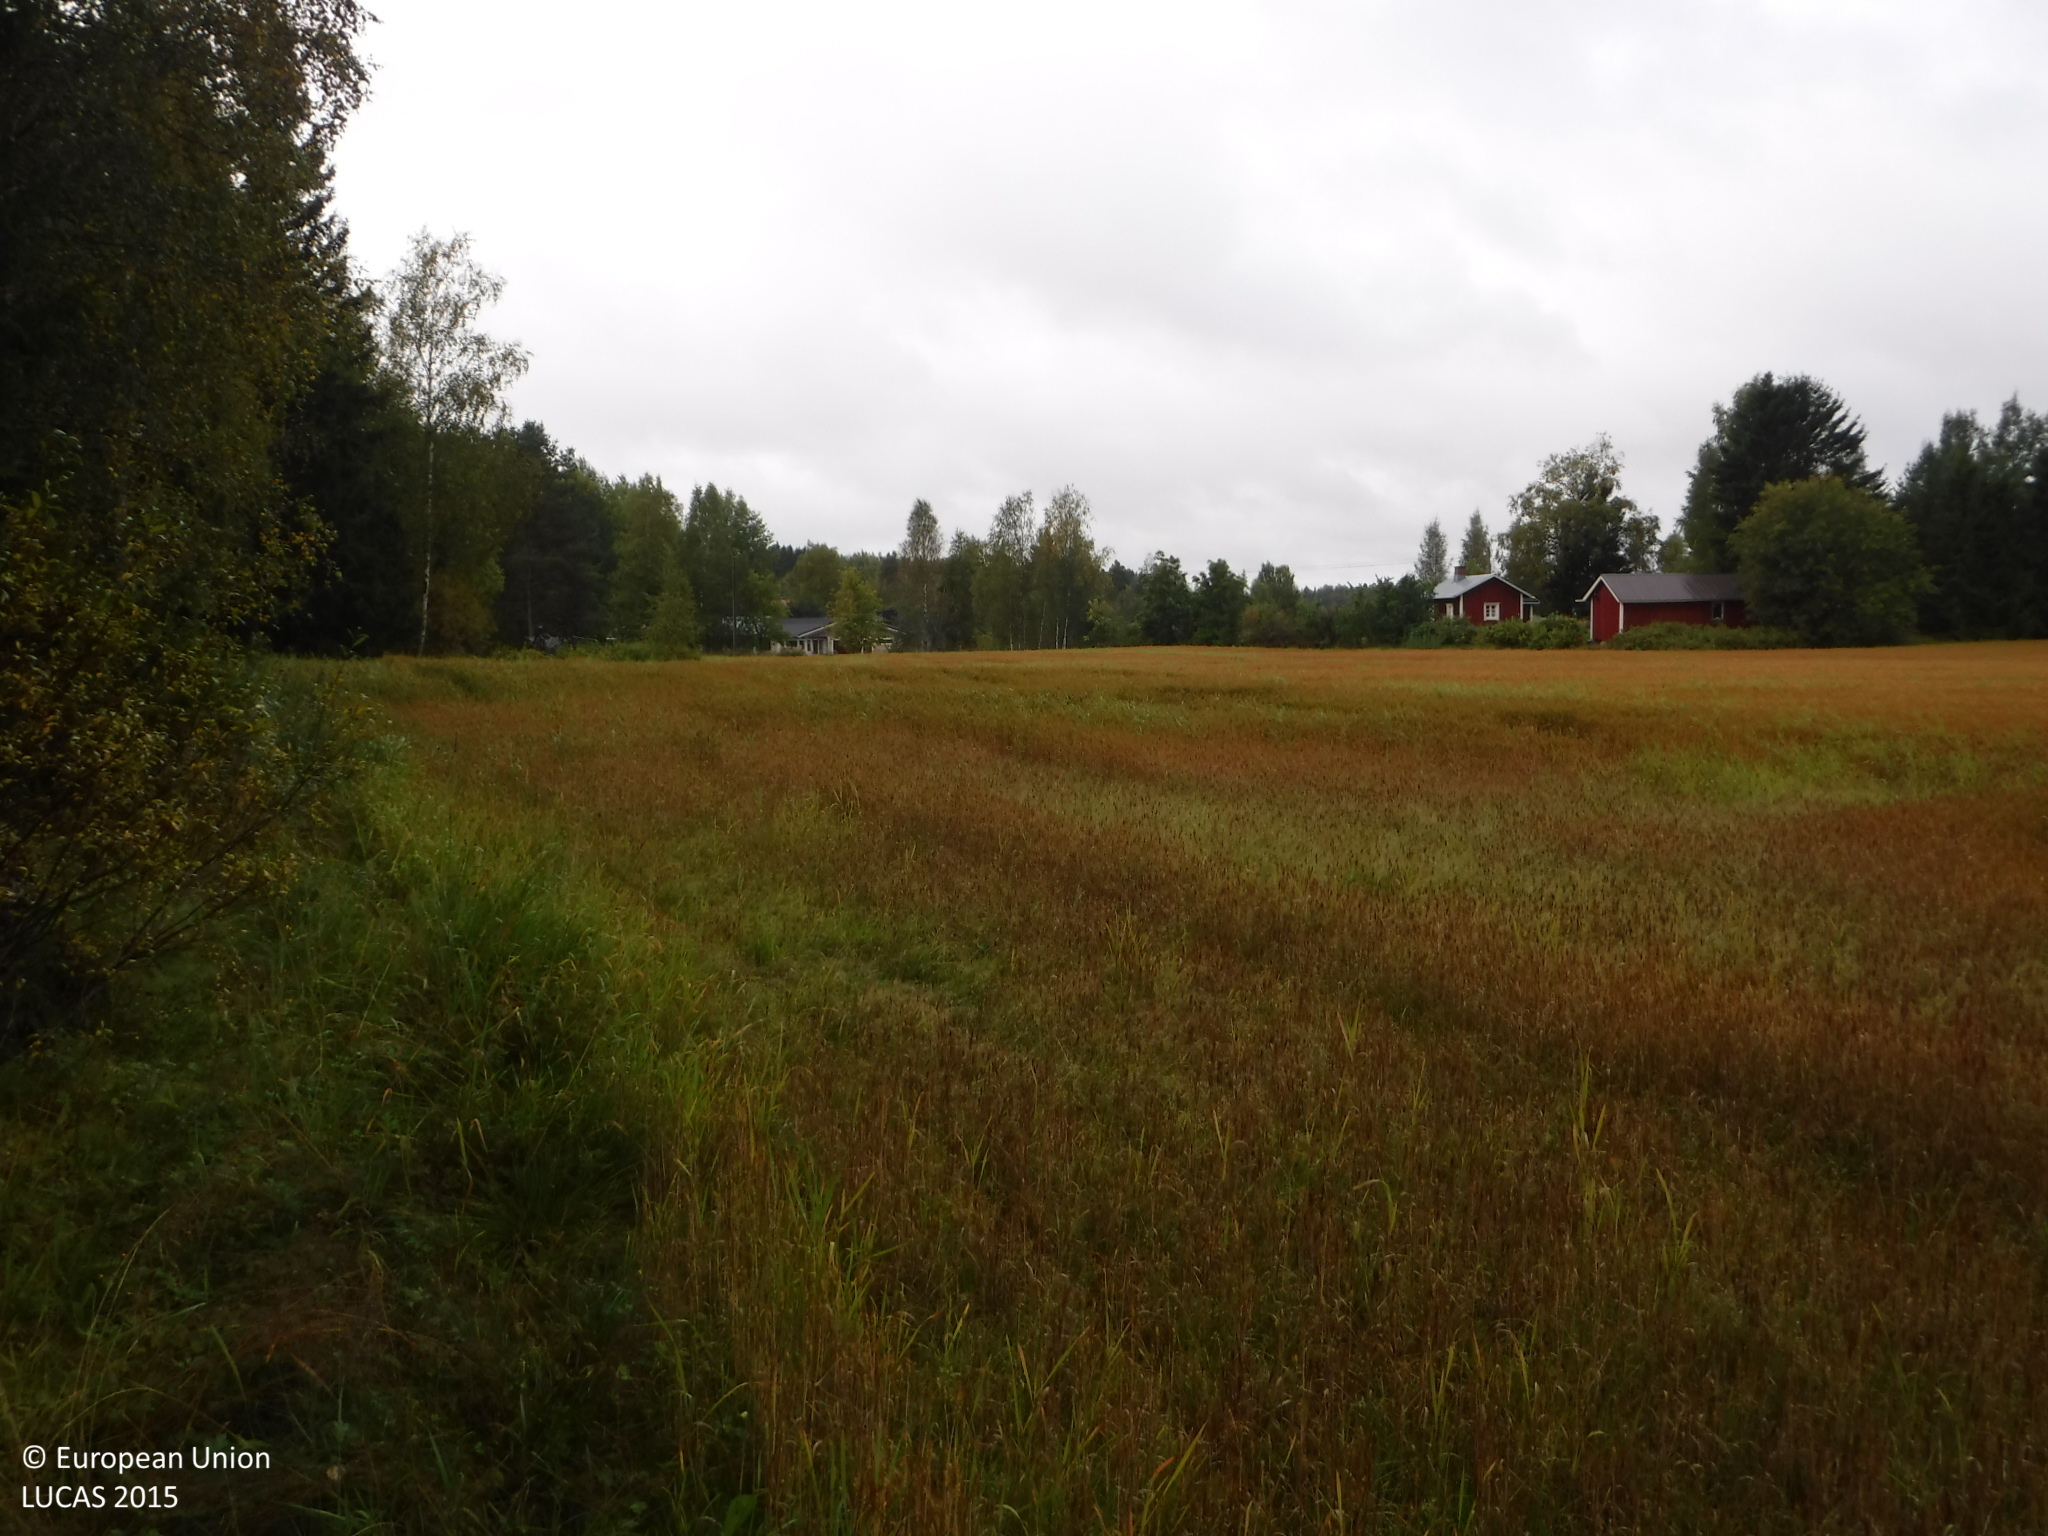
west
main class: Cropland
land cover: Common wheat
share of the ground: > 75 %
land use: Agriculture (excluding fallow land and kitchen gardens)
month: September
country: FI
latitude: 61.3298
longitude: 23.0212
